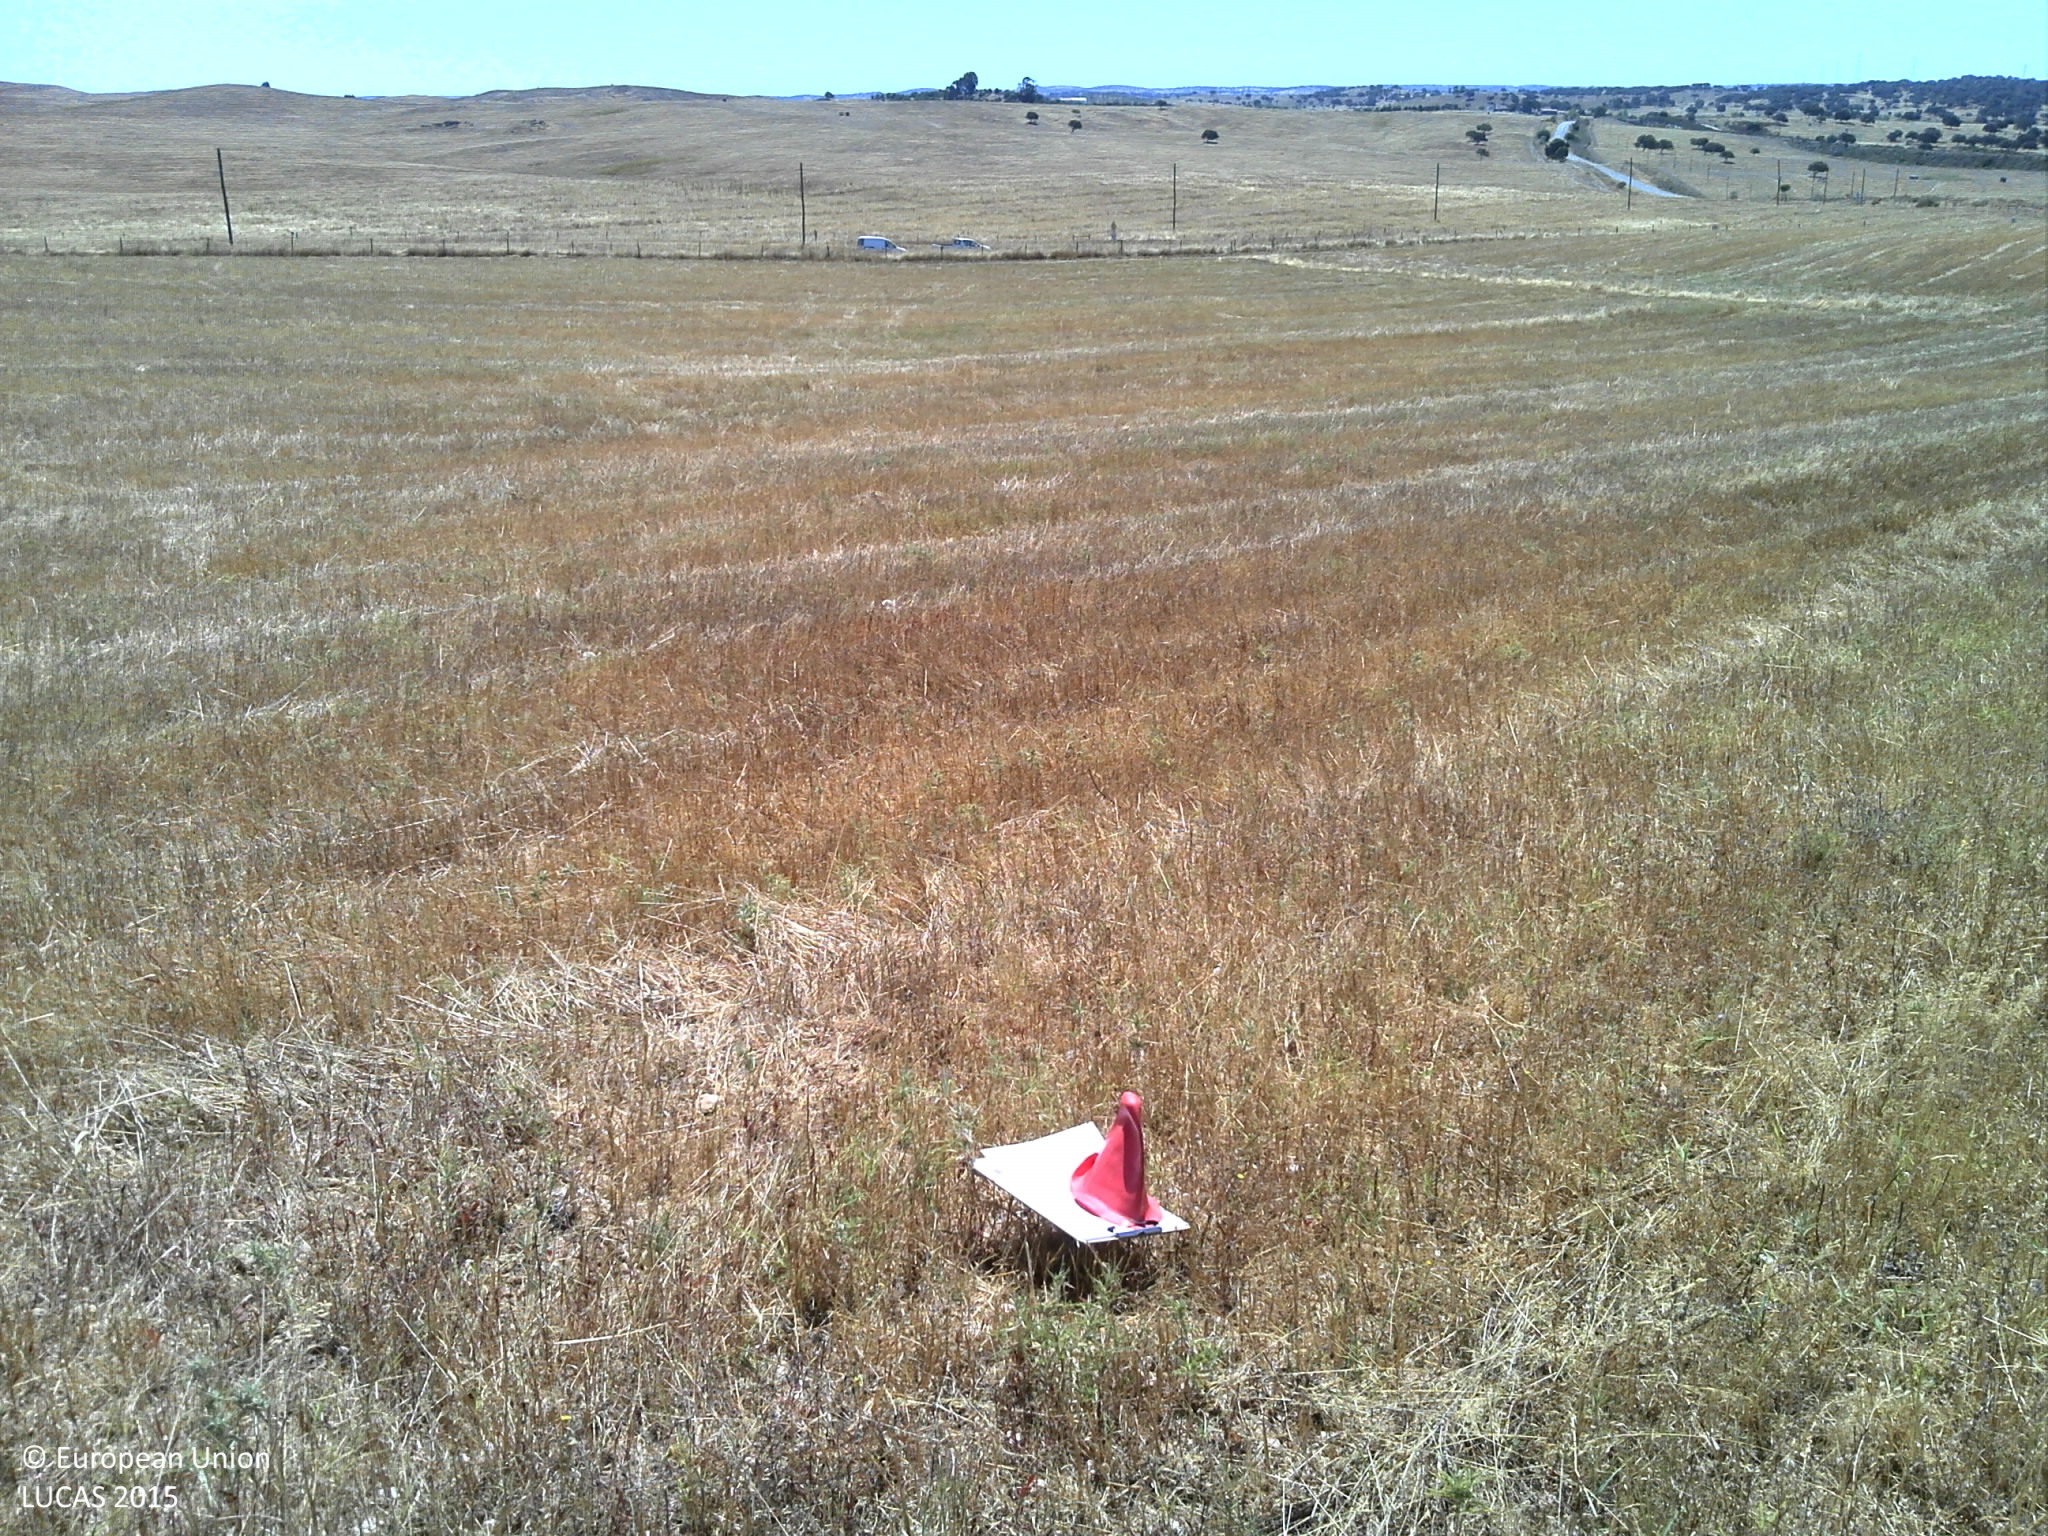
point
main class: Grassland
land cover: Spontaneously vegetated surfaces
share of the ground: 50 - 75 %
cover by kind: herbaceous plants 50 %, consolidated bare surface 50 %
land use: Agriculture (excluding fallow land and kitchen gardens)
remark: Harvested field
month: July
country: PT
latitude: 37.7532
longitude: -8.2948
